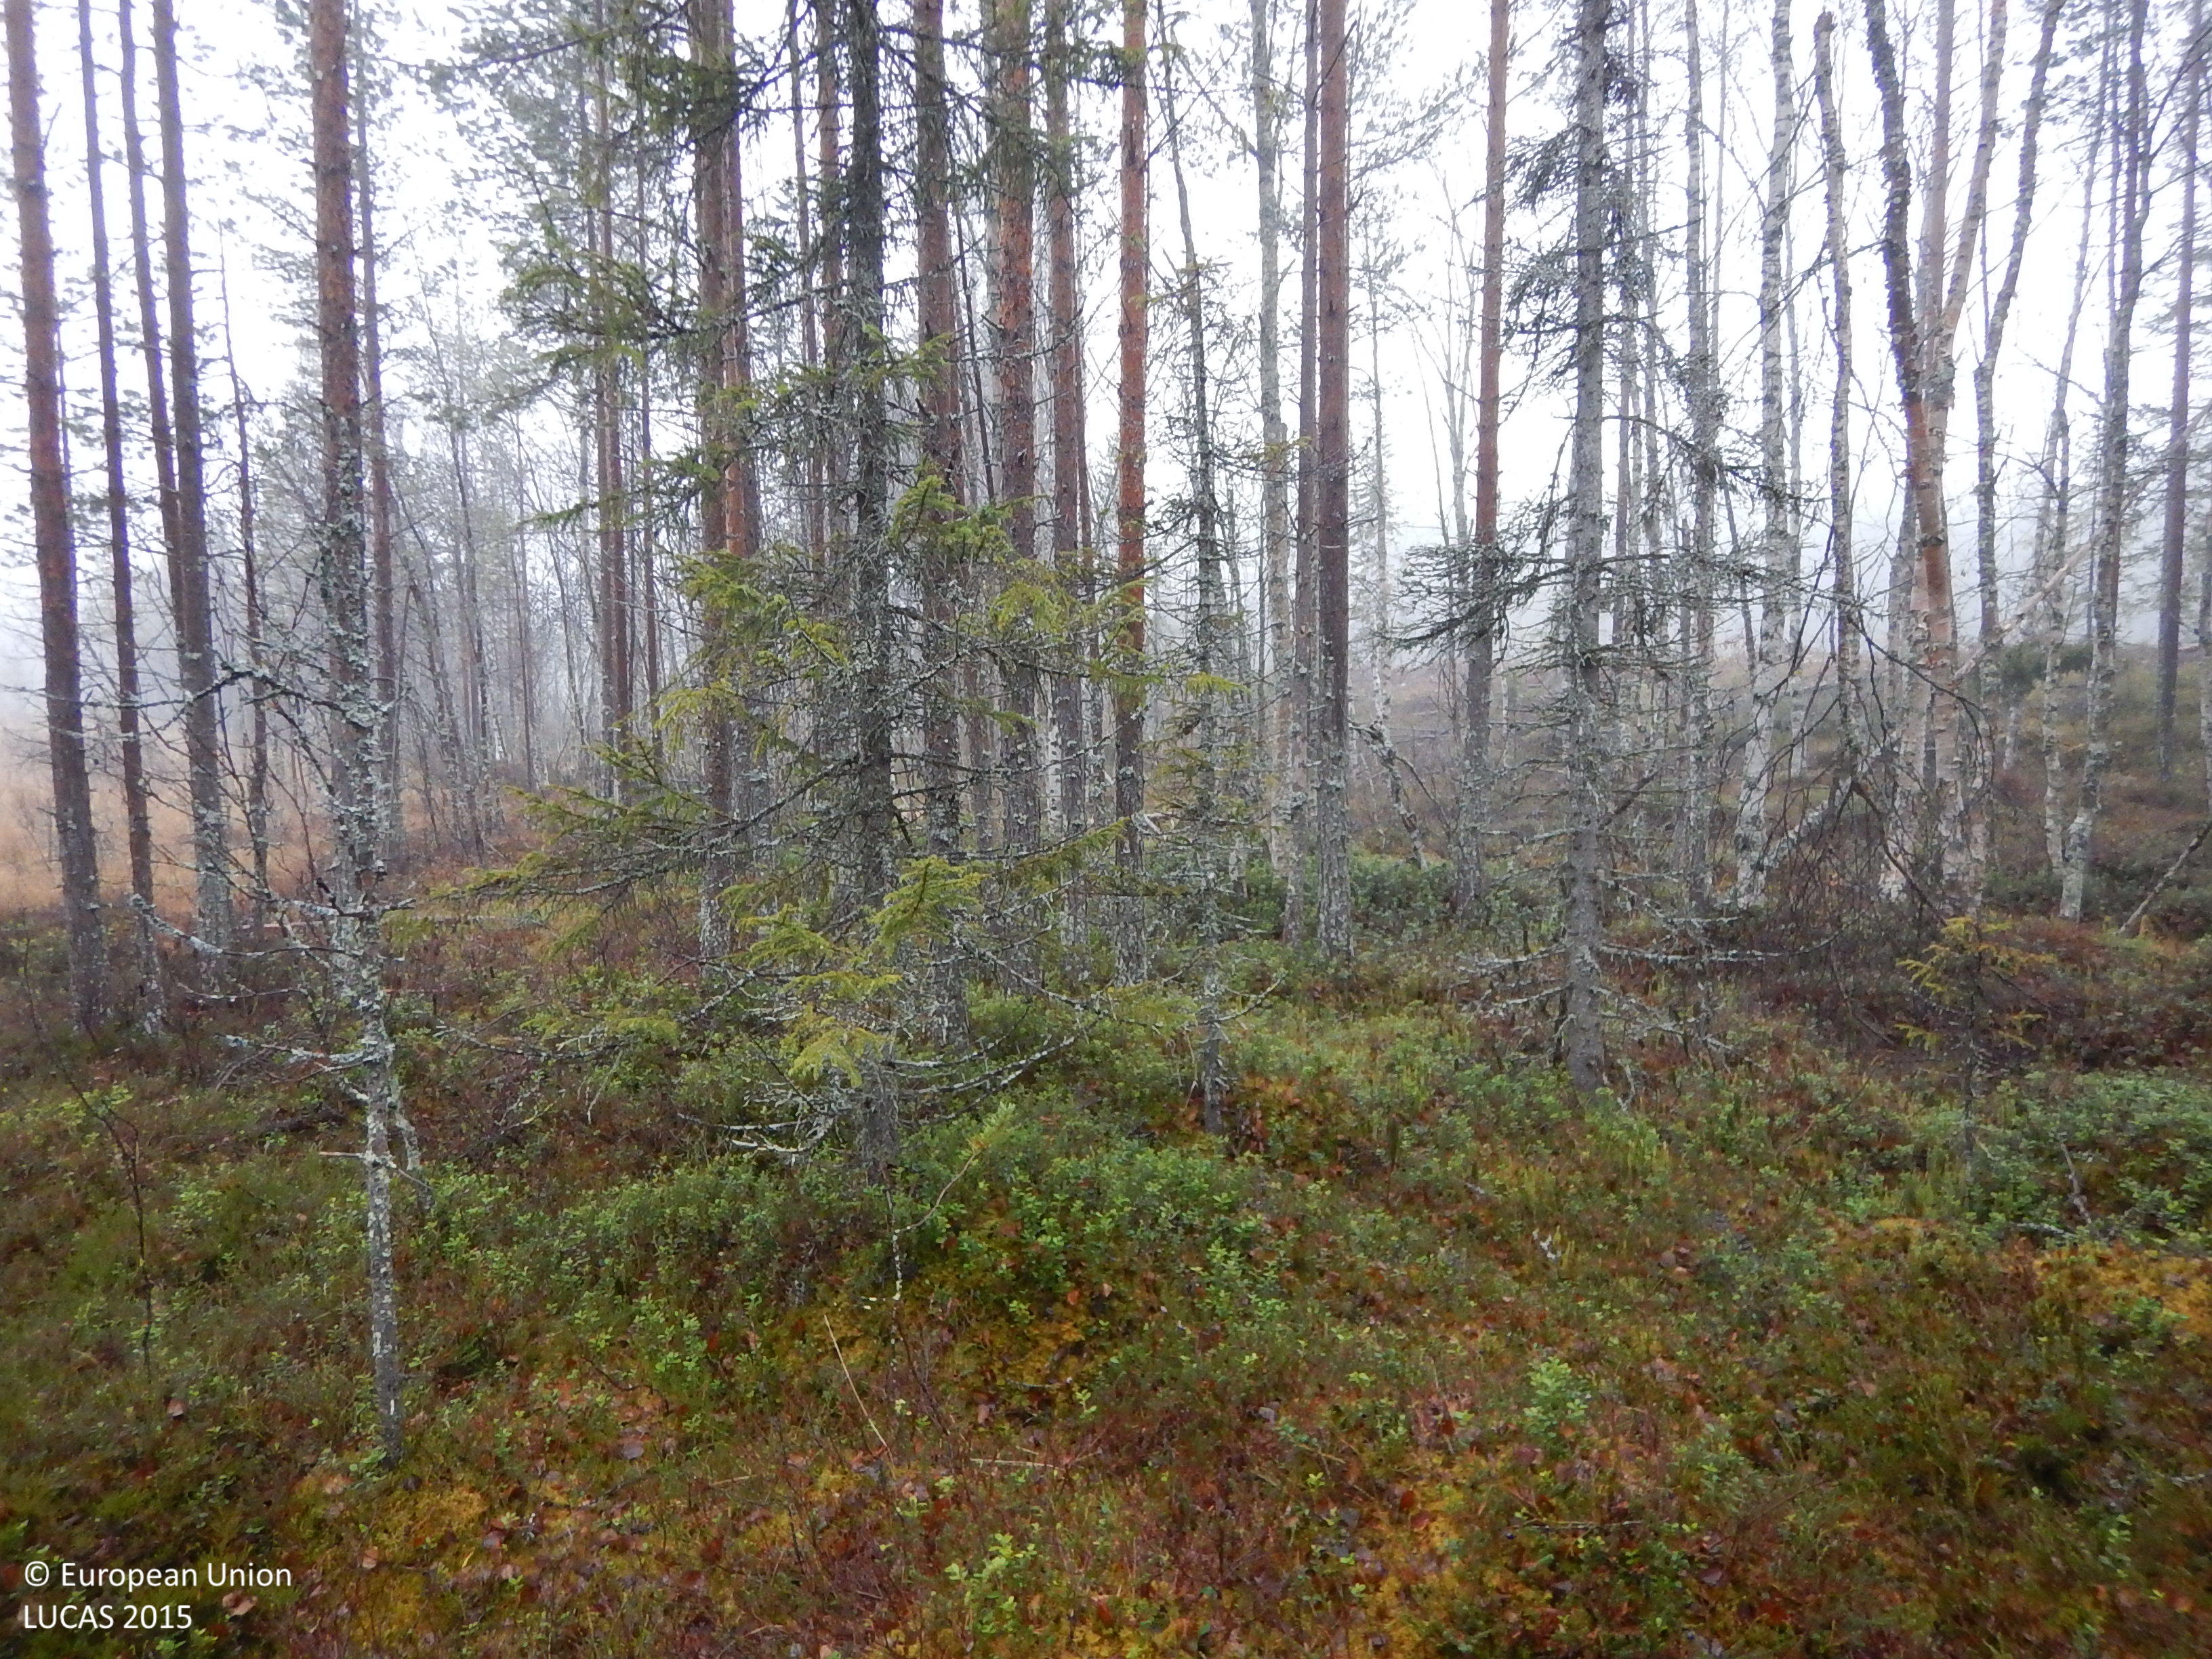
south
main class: Woodland
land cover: Pine dominated mixed woodland
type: mire and swamp forests
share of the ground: 50 - 75 %
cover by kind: coniferous forest trees 35 %, lichens and mosses 25 %, broadleaved forest trees 20 %, shrubs 15 %, herbaceous plants 5 %
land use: Forestry
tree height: > 5 m
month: November
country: SE
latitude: 65.1359
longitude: 20.3503
